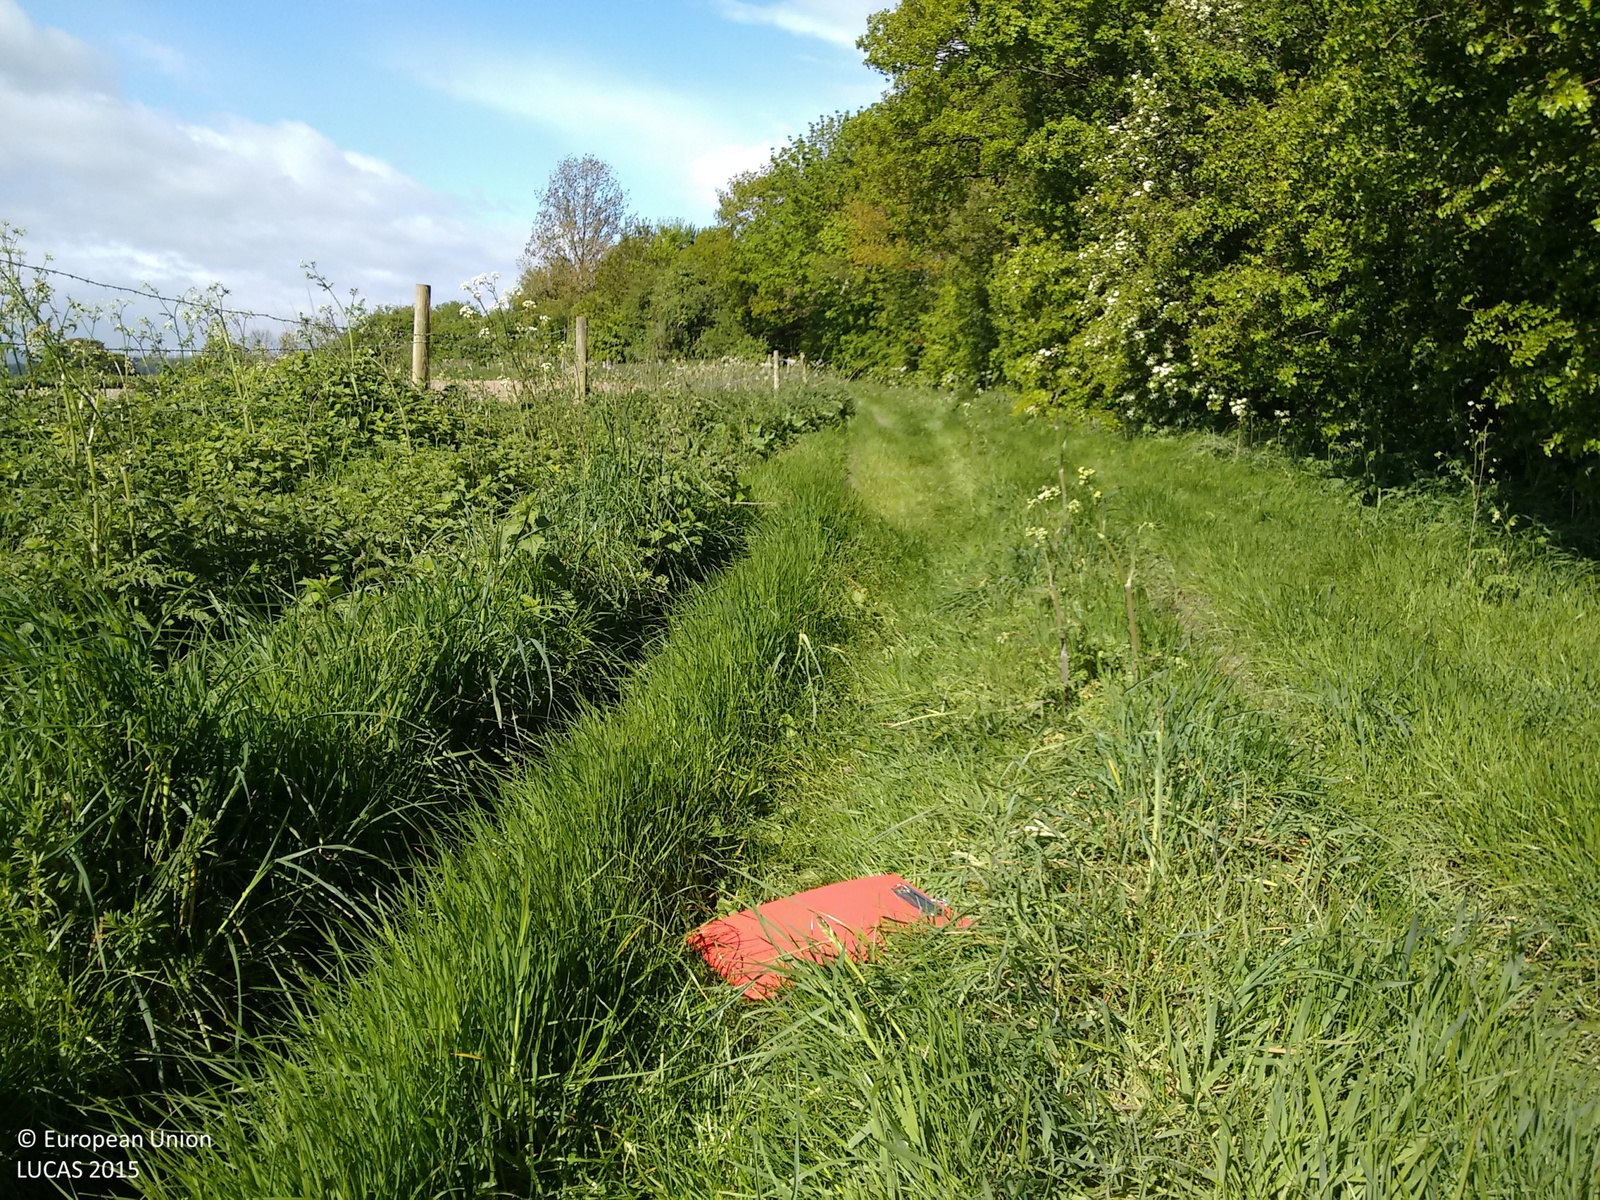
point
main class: Grassland
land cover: Grassland without tree/shrub cover
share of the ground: > 75 %
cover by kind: herbaceous plants 100 %
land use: Agriculture (excluding fallow land and kitchen gardens)
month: May
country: GB
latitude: 53.5894
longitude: -1.5779
